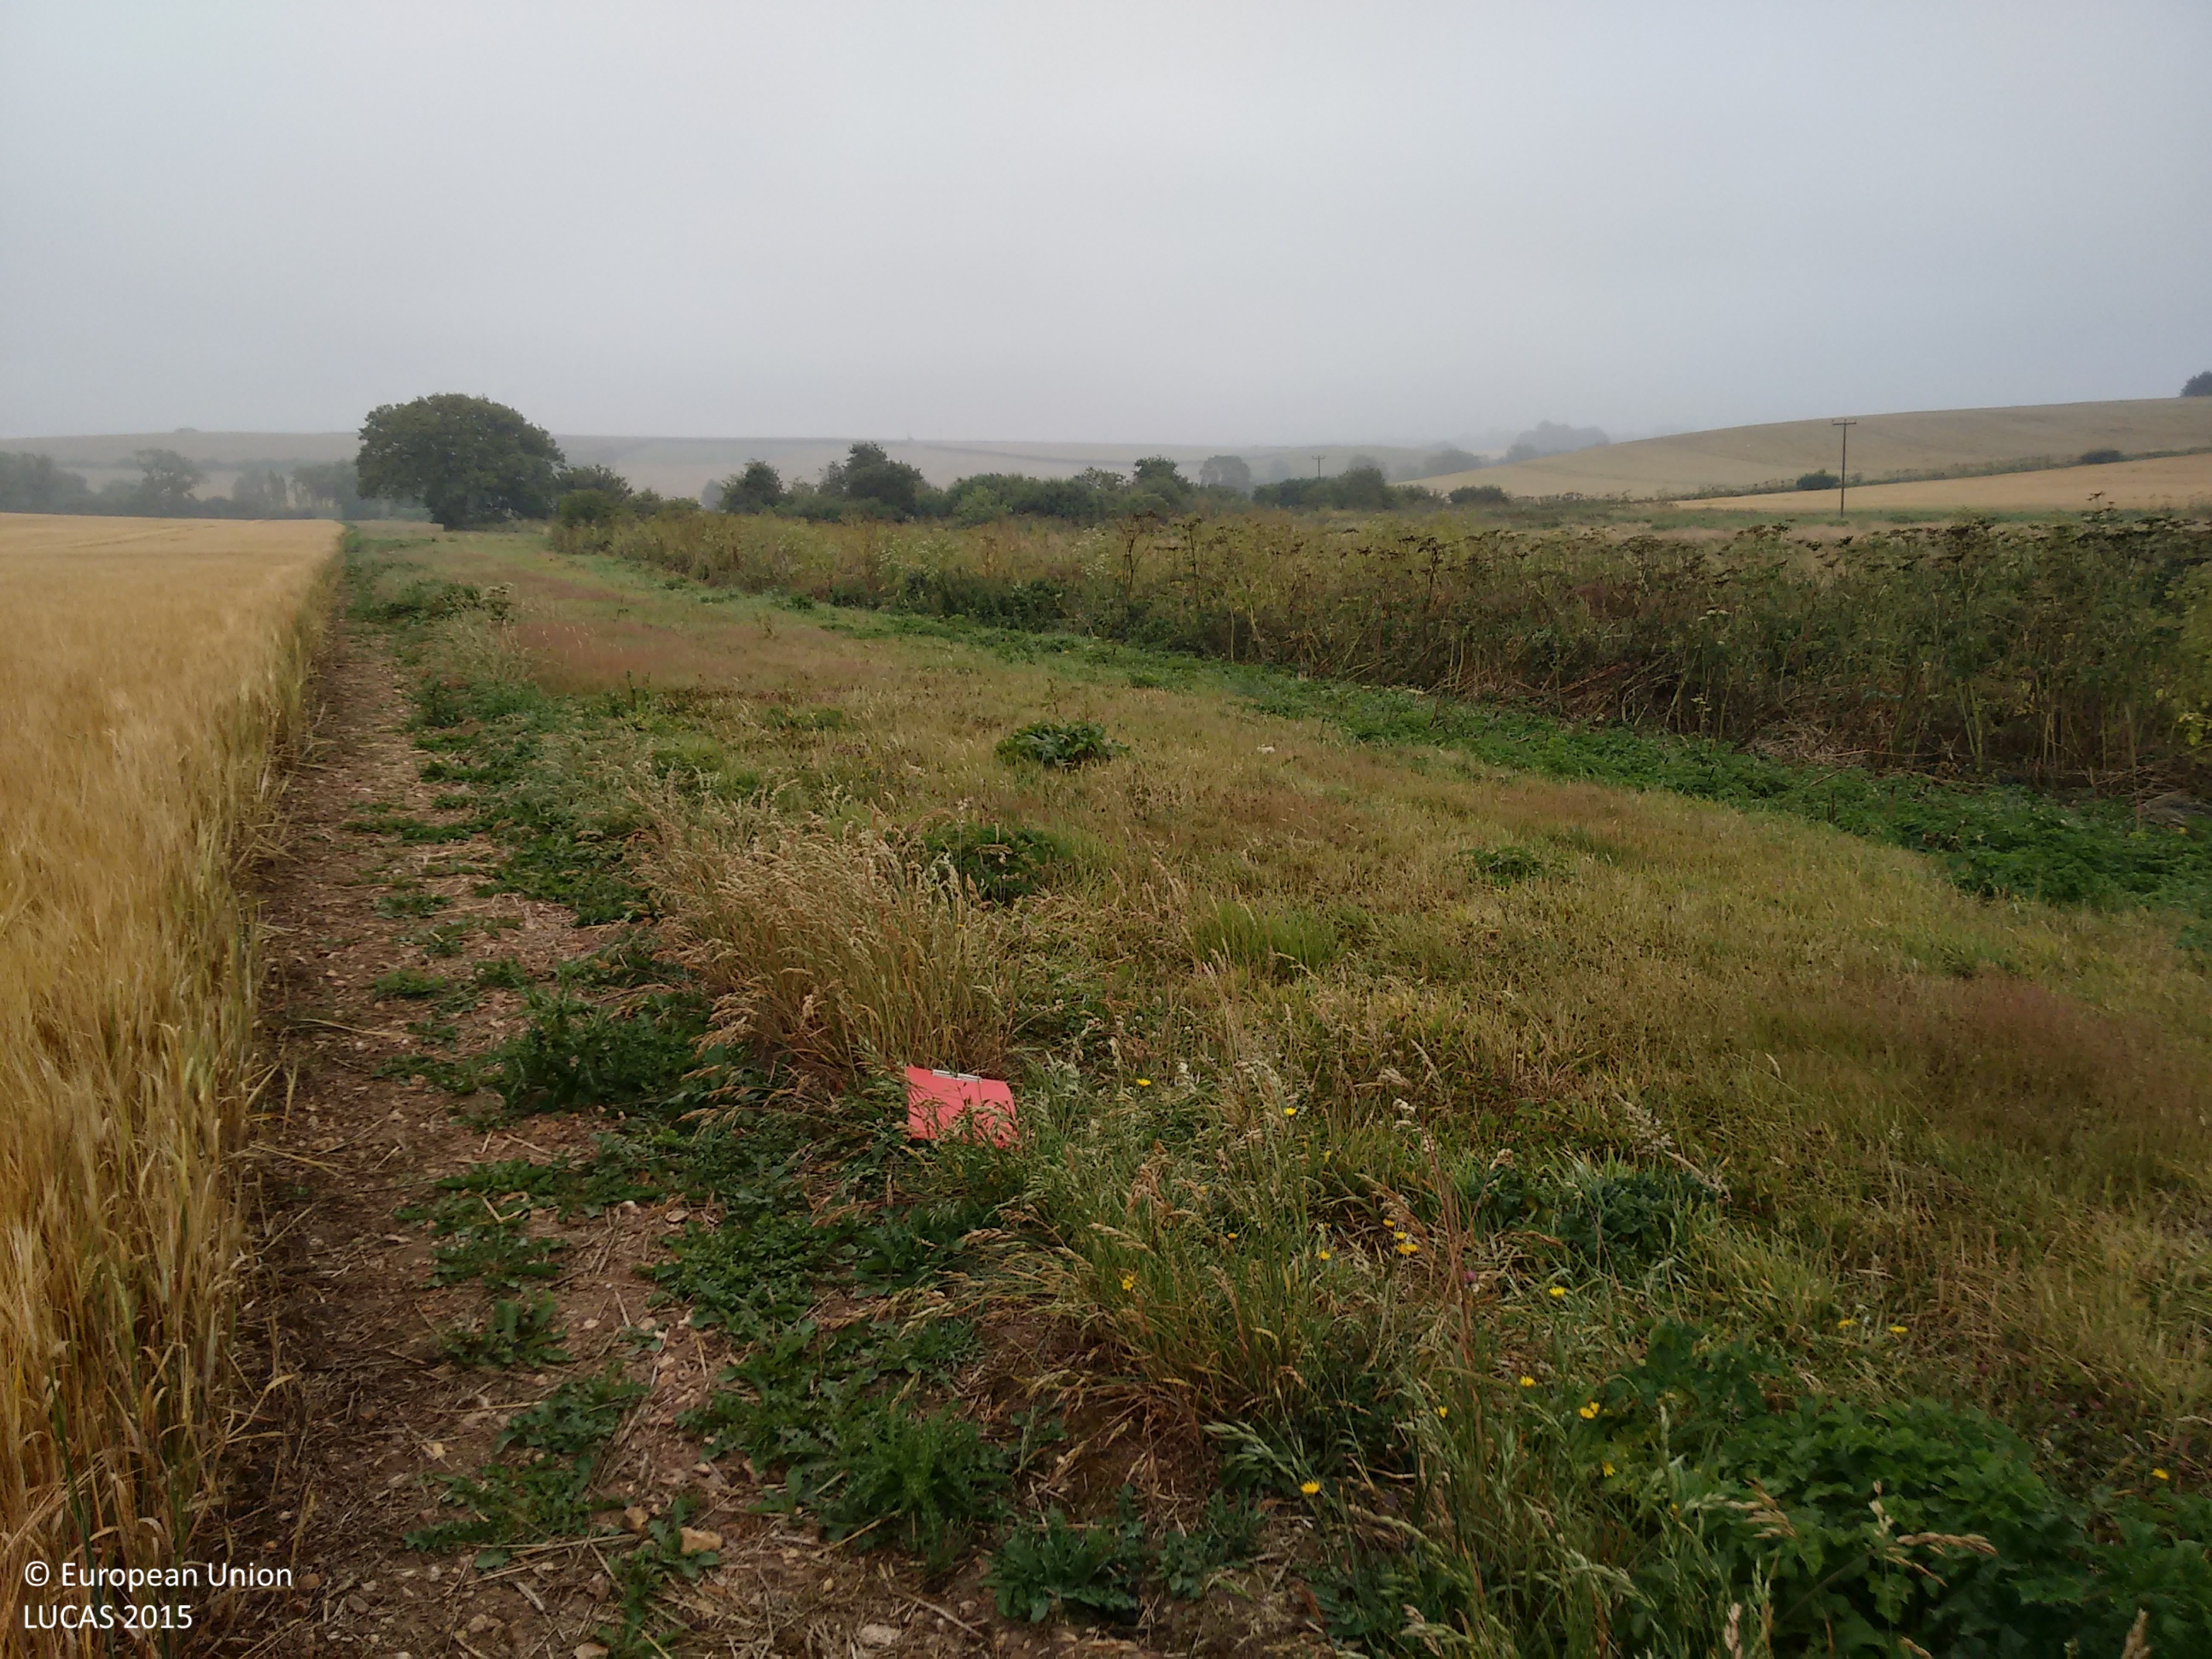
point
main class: Grassland
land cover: Grassland without tree/shrub cover
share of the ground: > 75 %
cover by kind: herbaceous plants 100 %
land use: Agriculture (excluding fallow land and kitchen gardens)
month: July
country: GB
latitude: 50.7589
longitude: -2.2392
